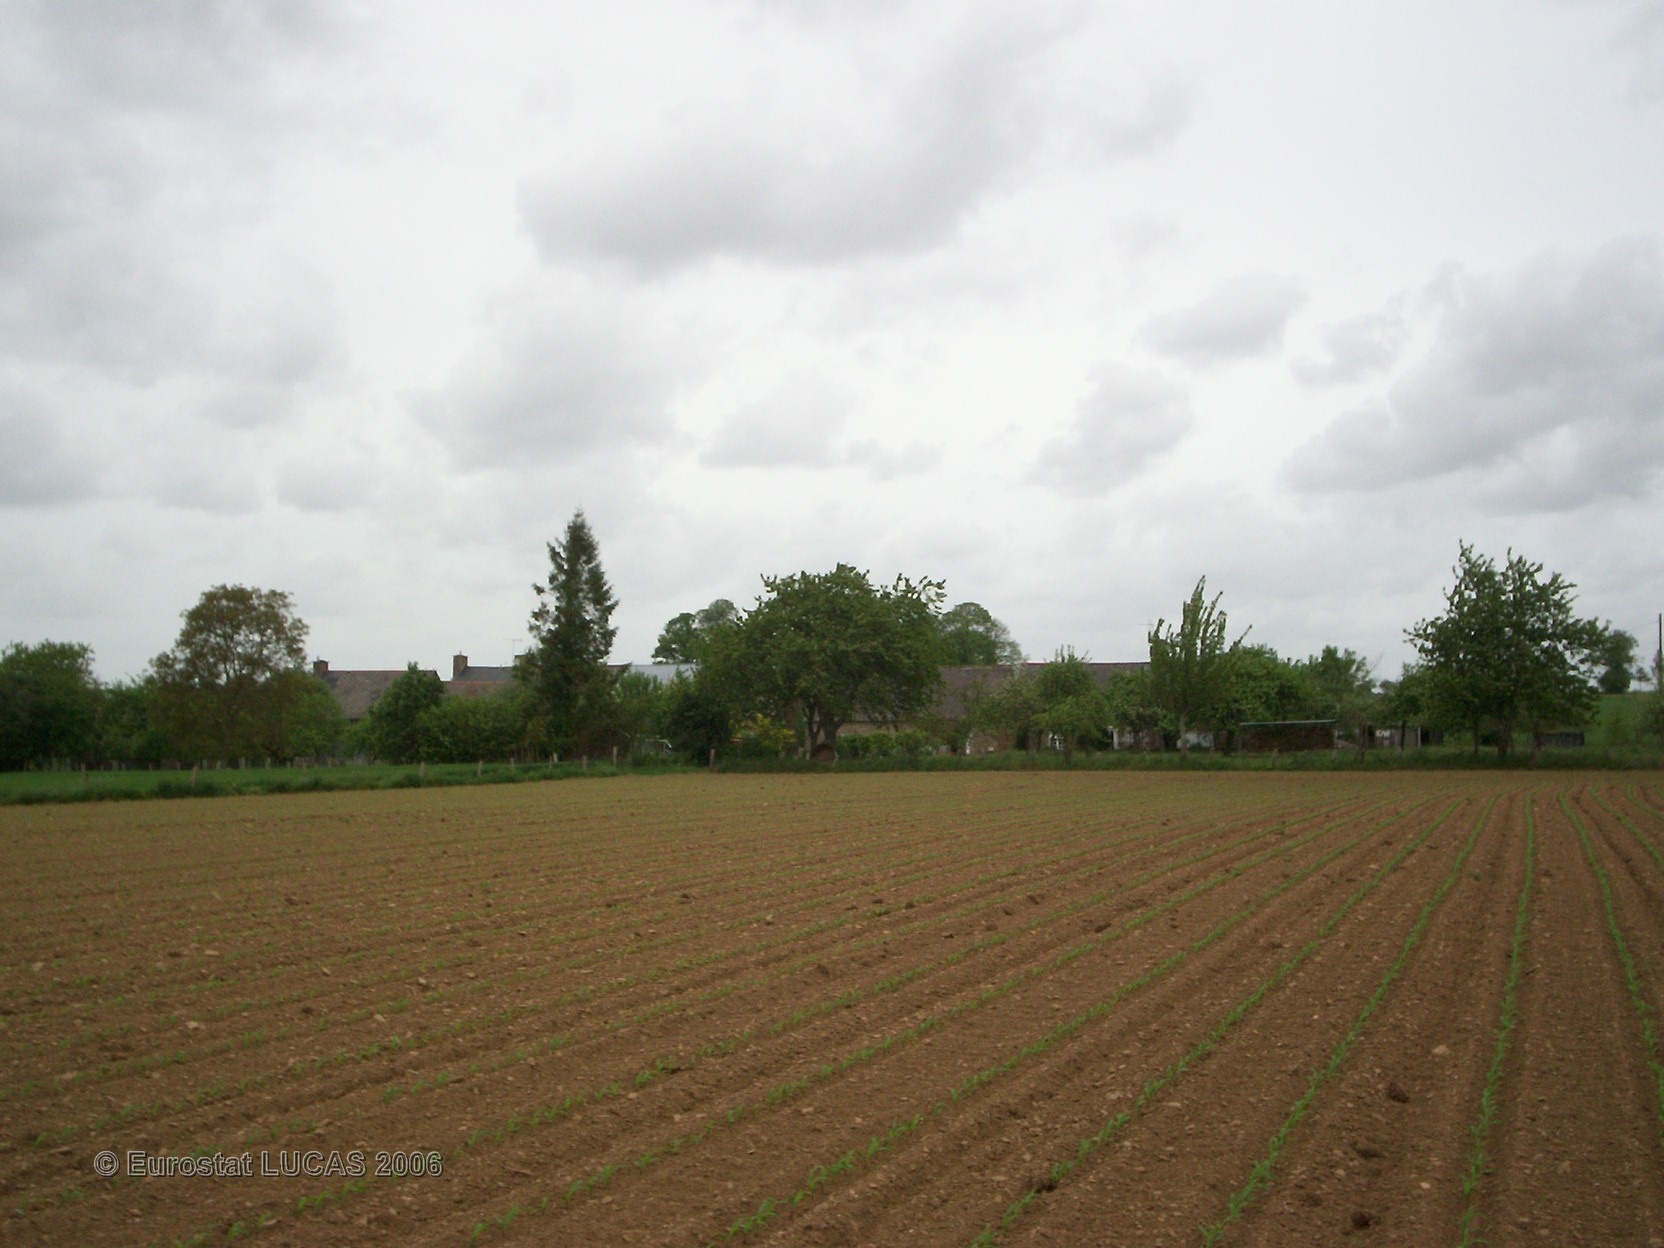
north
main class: Cropland
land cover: Maize
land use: Agriculture (excluding fallow land and kitchen gardens)
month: May
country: FR
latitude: 48.4638
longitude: -1.4196
